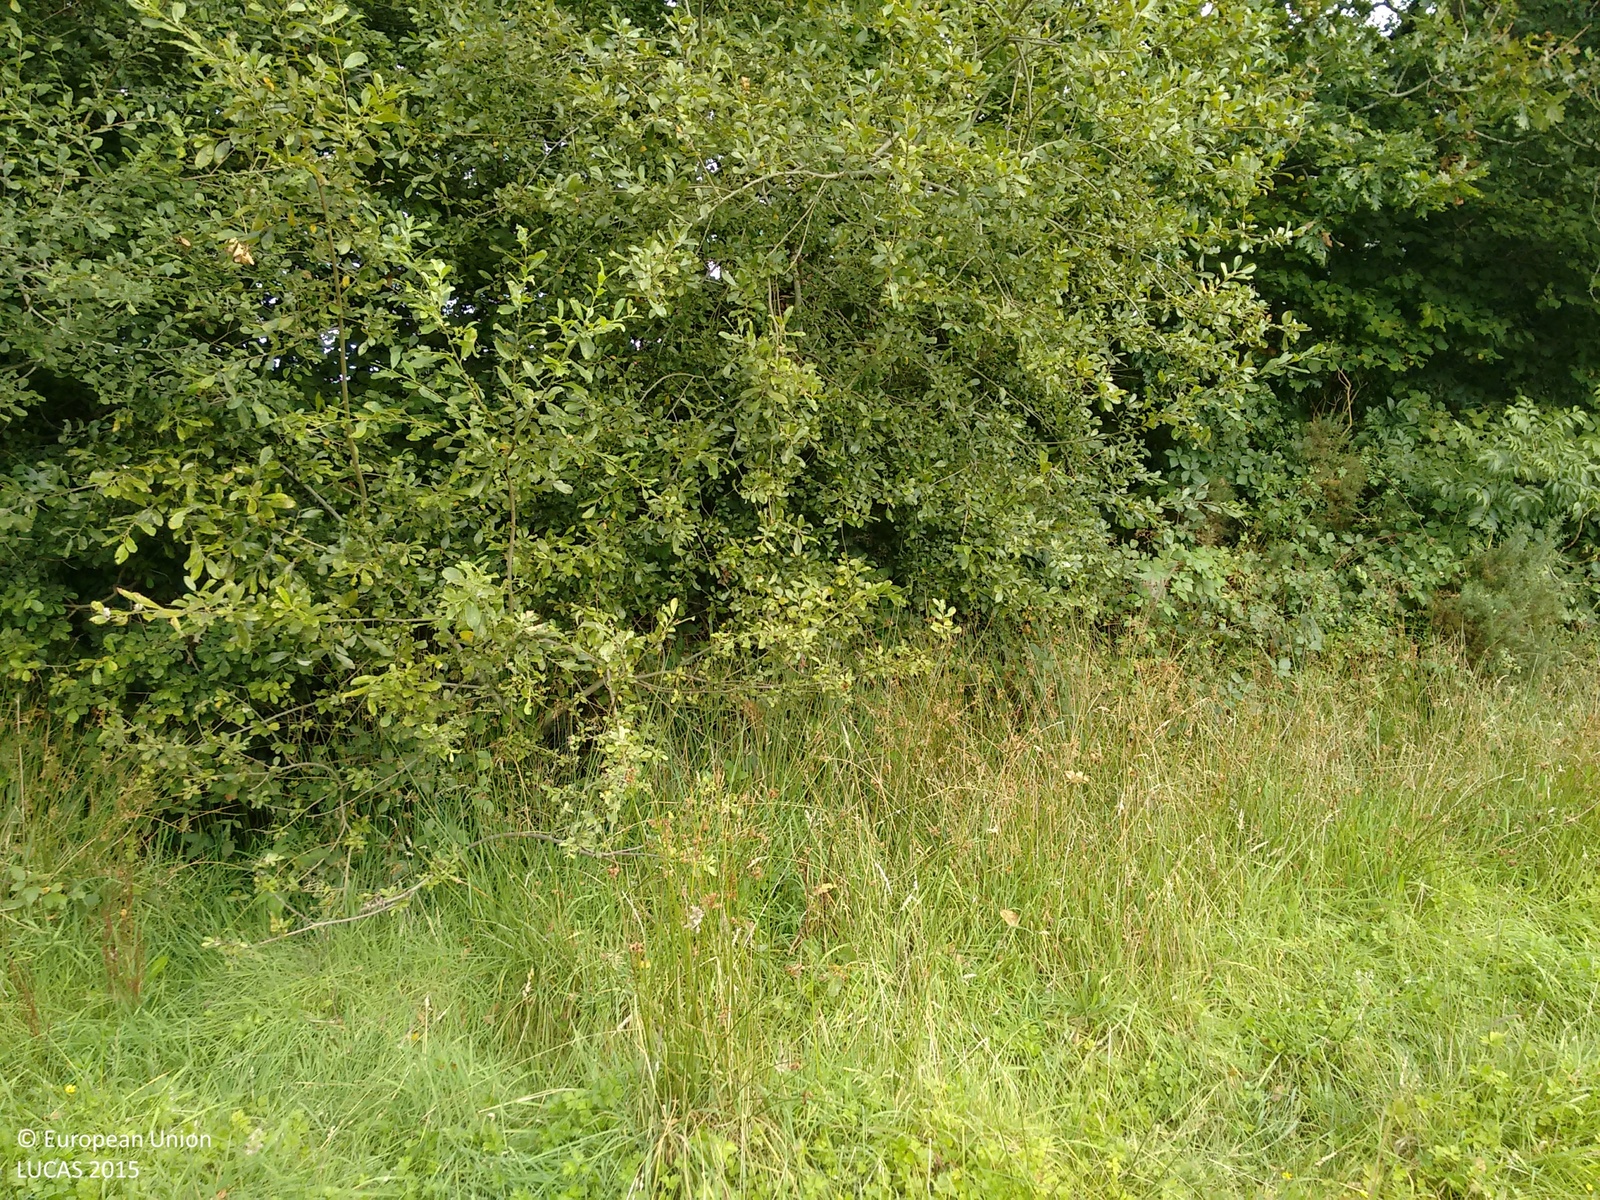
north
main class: Grassland
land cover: Grassland without tree/shrub cover
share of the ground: > 75 %
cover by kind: herbaceous plants 100 %
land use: Agriculture (excluding fallow land and kitchen gardens)
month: September
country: GB
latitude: 50.8314
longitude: -4.1390
